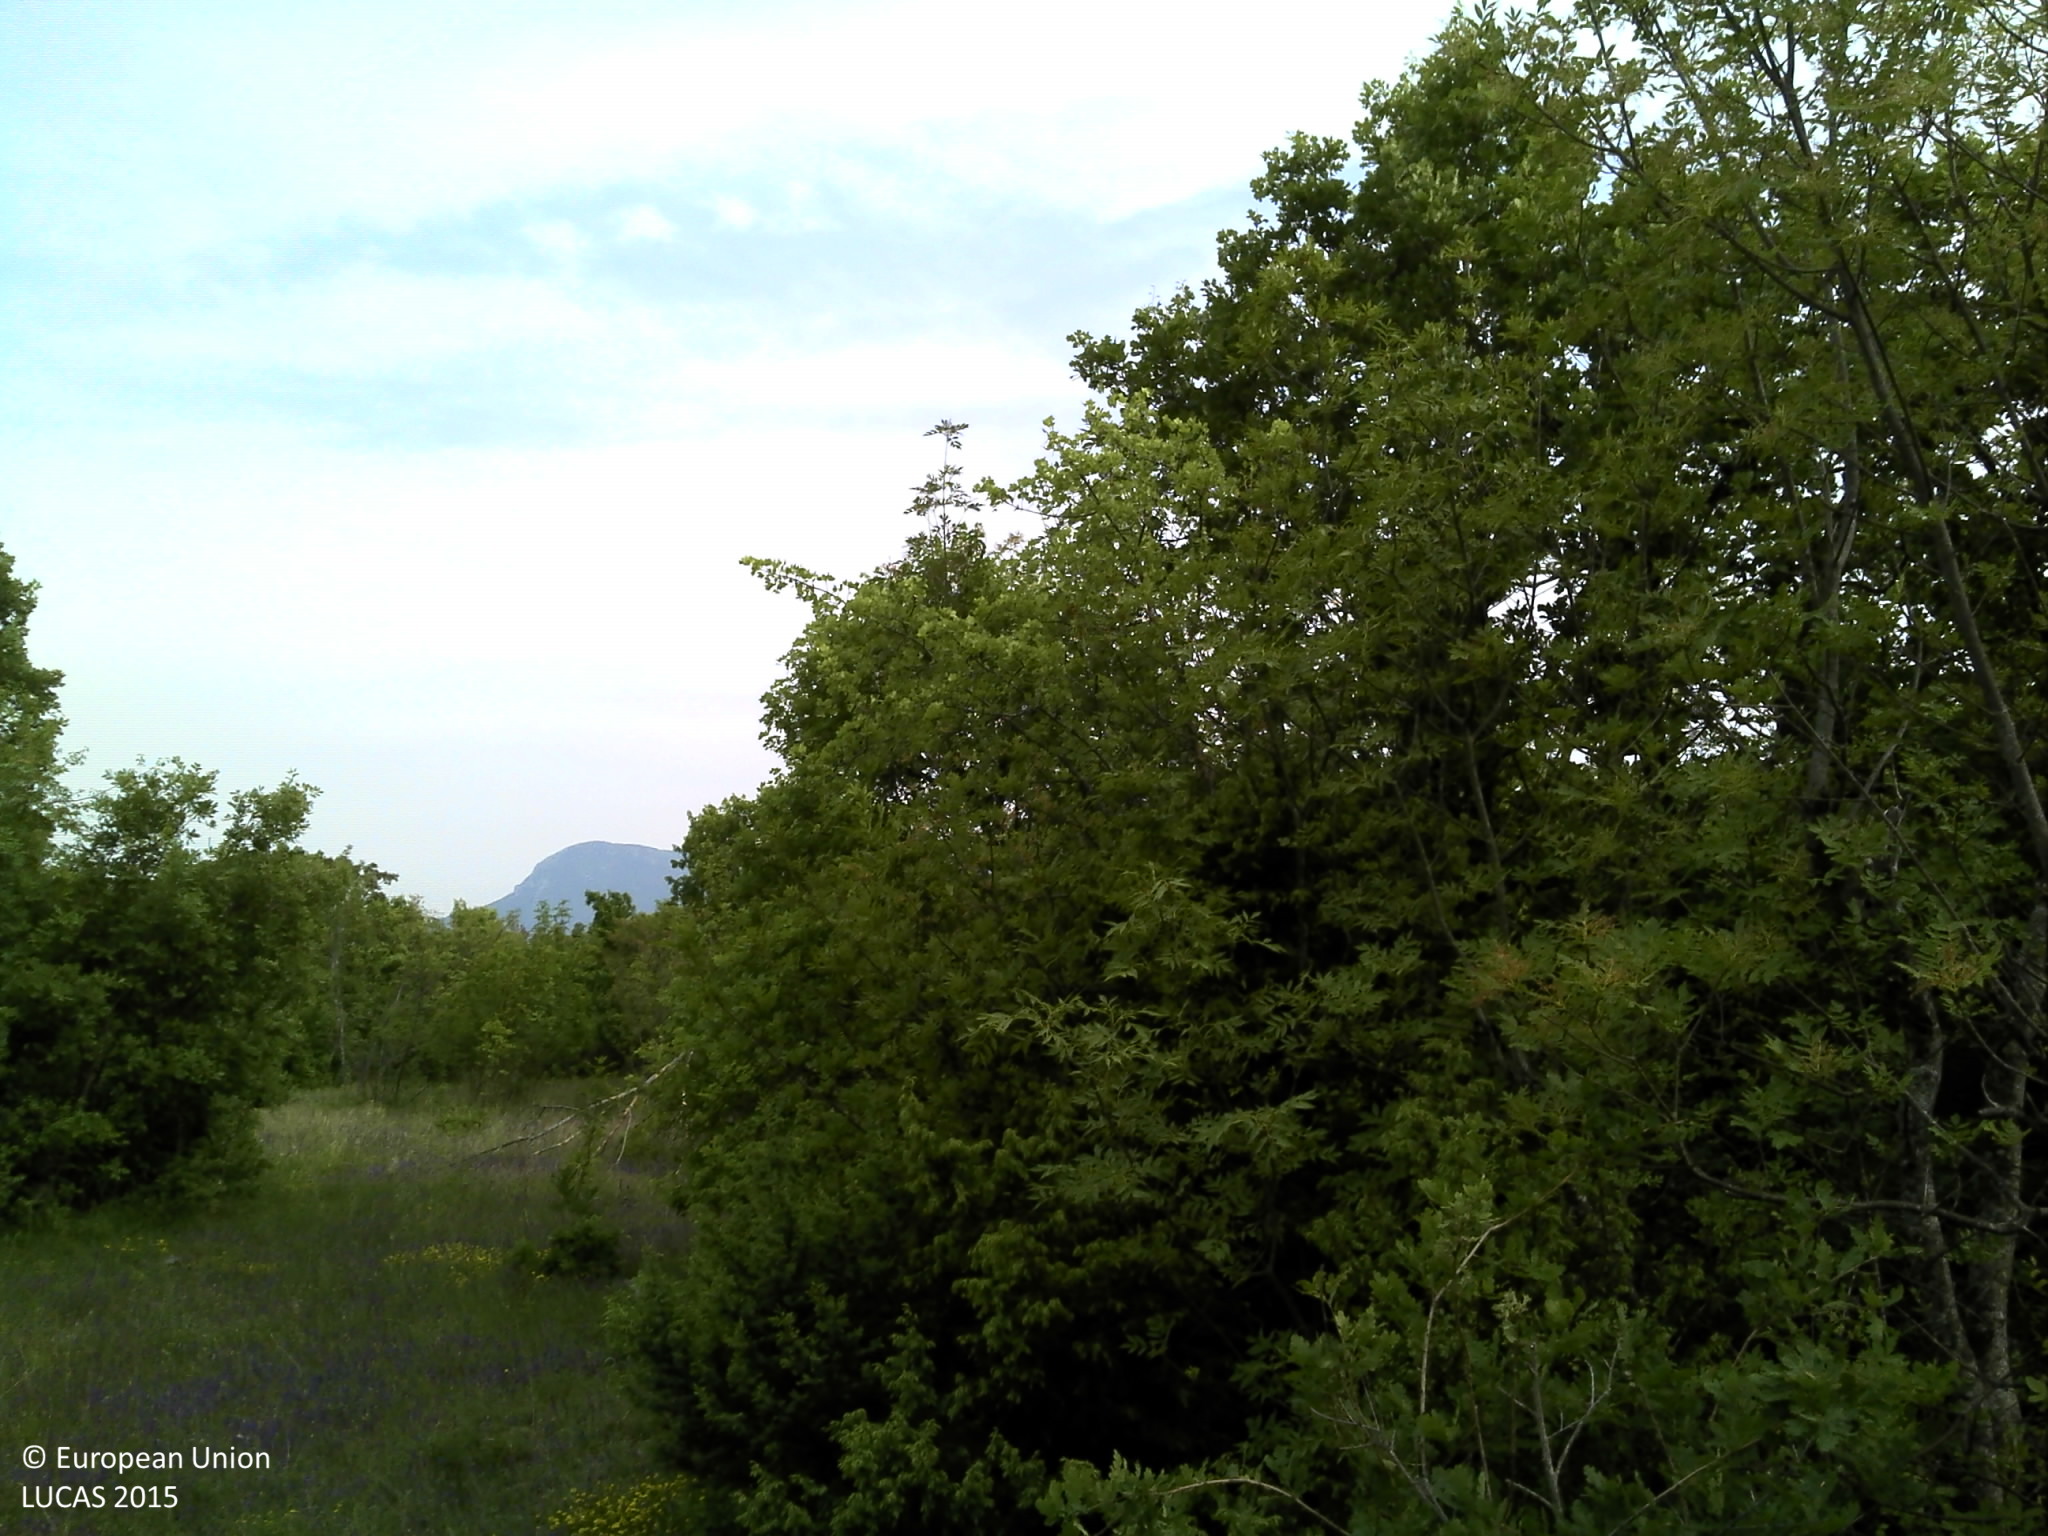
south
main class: Woodland
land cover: Broadleaved woodland
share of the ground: 25 - 50 %
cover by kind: shrubs 40 %, herbaceous plants 30 %, broadleaved forest trees 25 %, coniferous forest trees 5 %
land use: Semi-natural and natural areas not in use
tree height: < 5 m
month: May
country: HR
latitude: 44.0164
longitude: 16.2671
